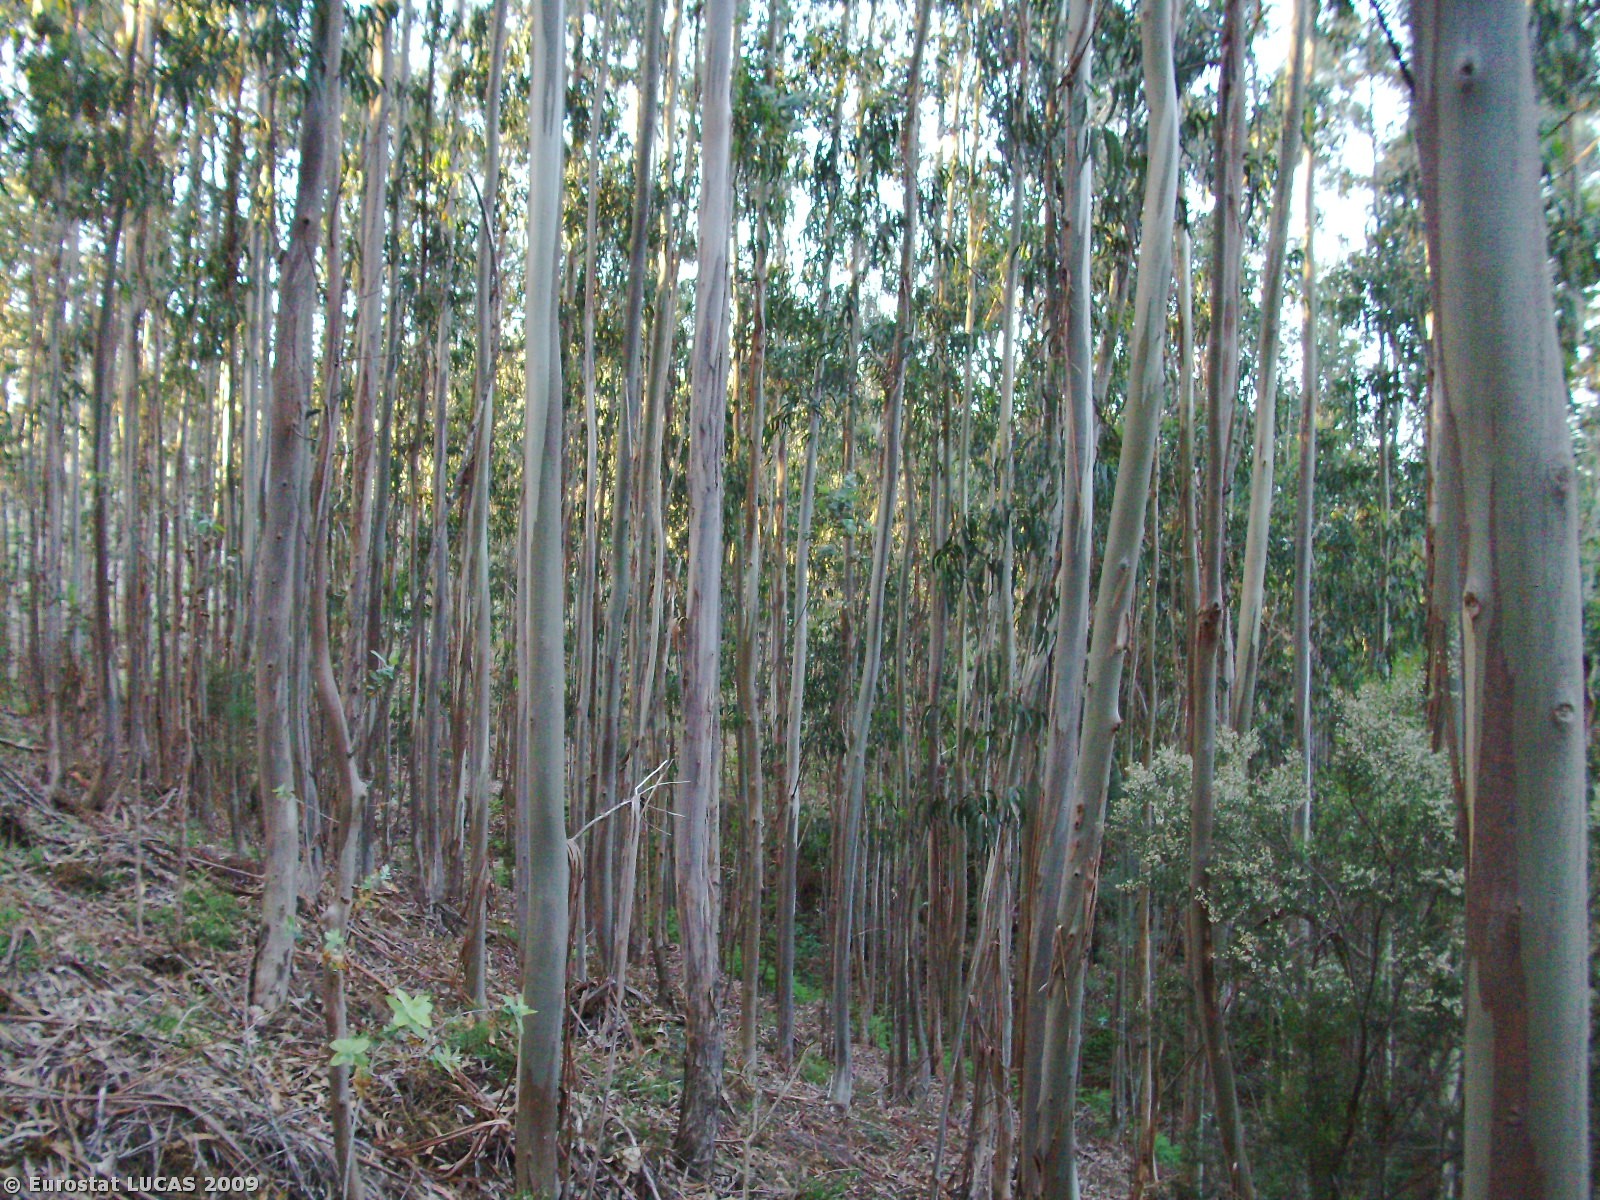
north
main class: Woodland
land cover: Broadleaved woodland
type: plantations and self-sown exotic forest
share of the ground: > 75 %
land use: Forestry
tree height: > 5 m
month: May
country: PT
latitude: 40.7757
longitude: -8.4471
